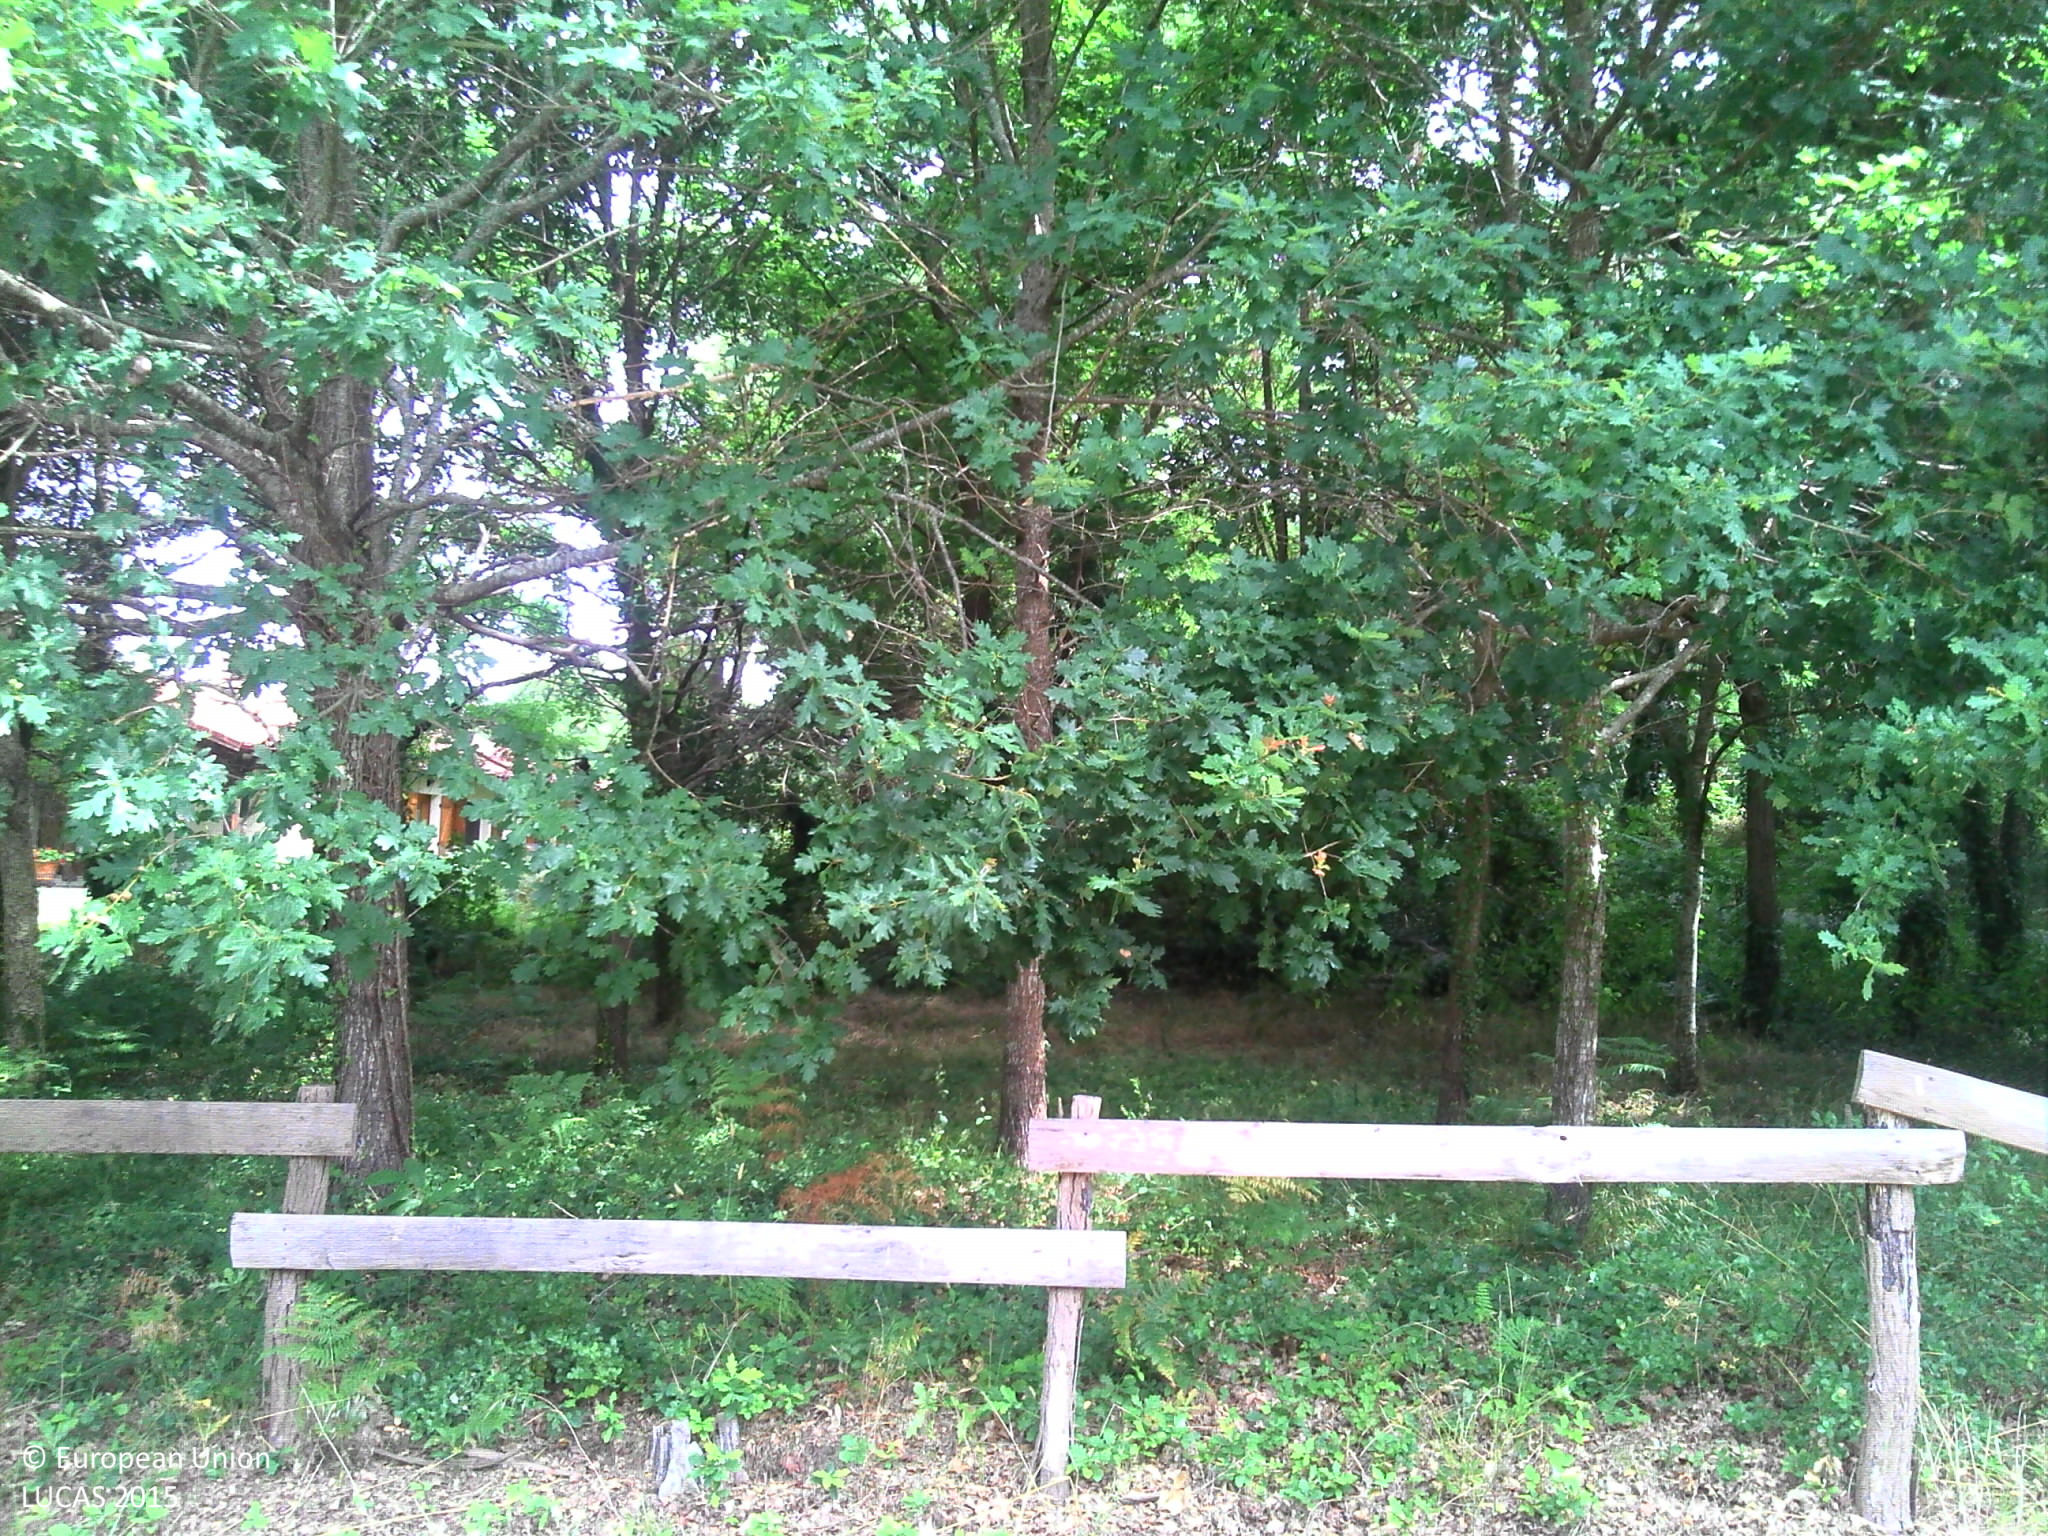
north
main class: Grassland
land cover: Grassland without tree/shrub cover
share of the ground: > 75 %
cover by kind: herbaceous plants 100 %
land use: Residential
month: July
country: FR
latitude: 43.8761
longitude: -1.3070
